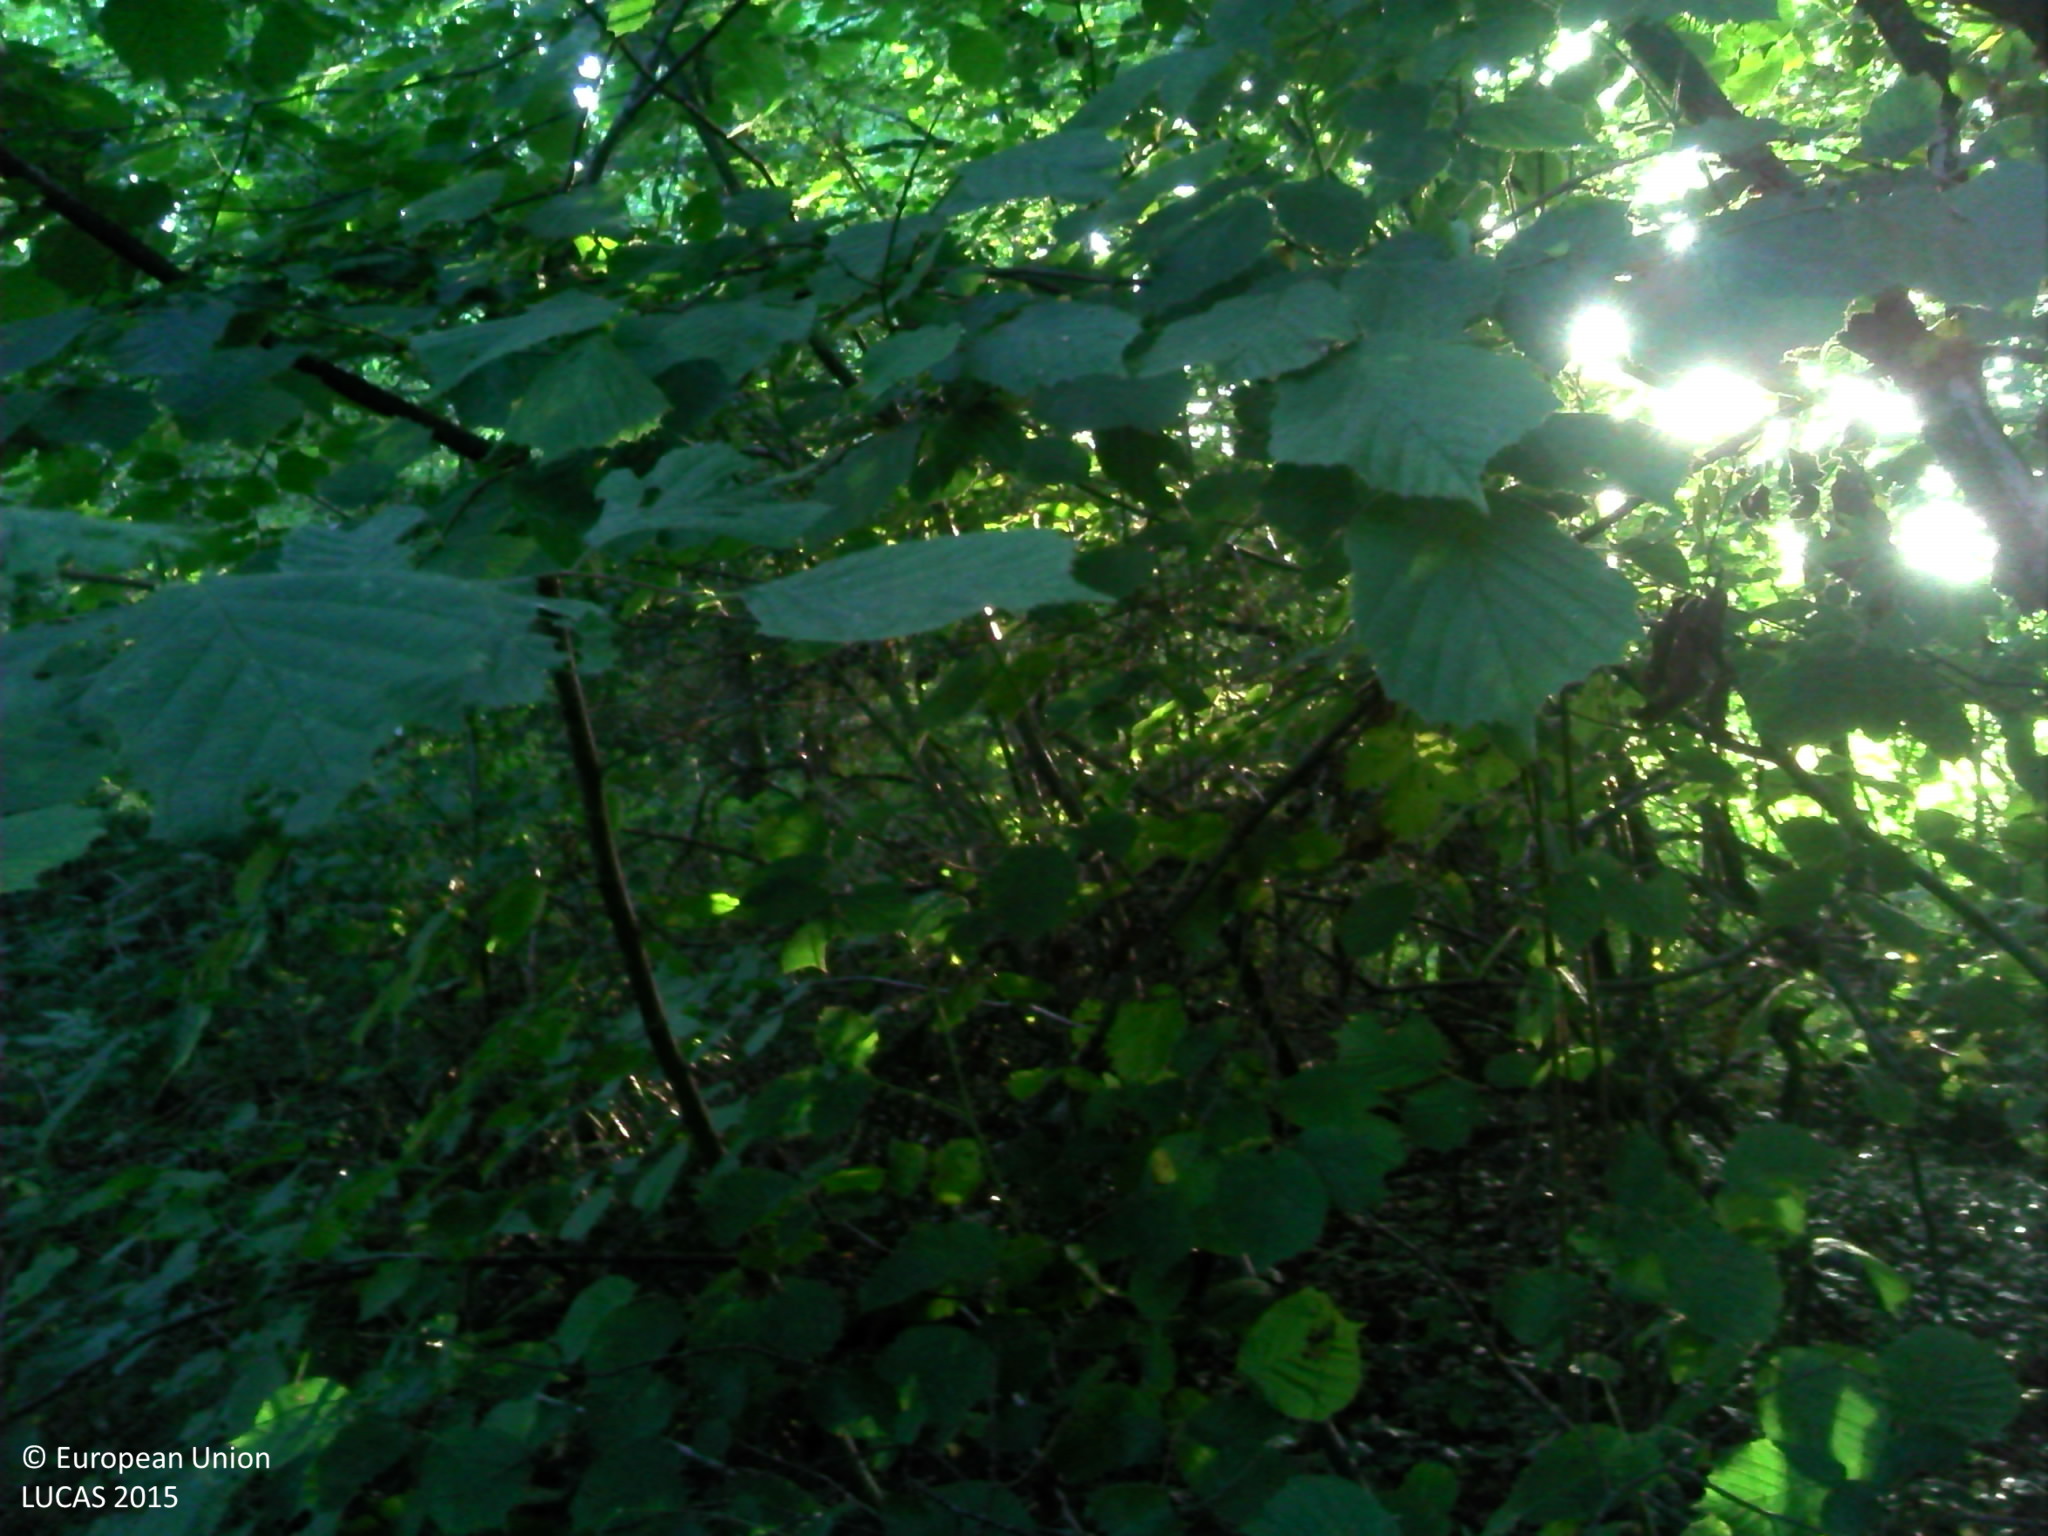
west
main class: Woodland
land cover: Broadleaved woodland
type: mesophytic deciduous forest
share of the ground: > 75 %
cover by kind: broadleaved forest trees 95 %, shrubs 5 %
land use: Forestry
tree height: > 5 m
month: July
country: FR
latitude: 46.8661
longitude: -0.8813
